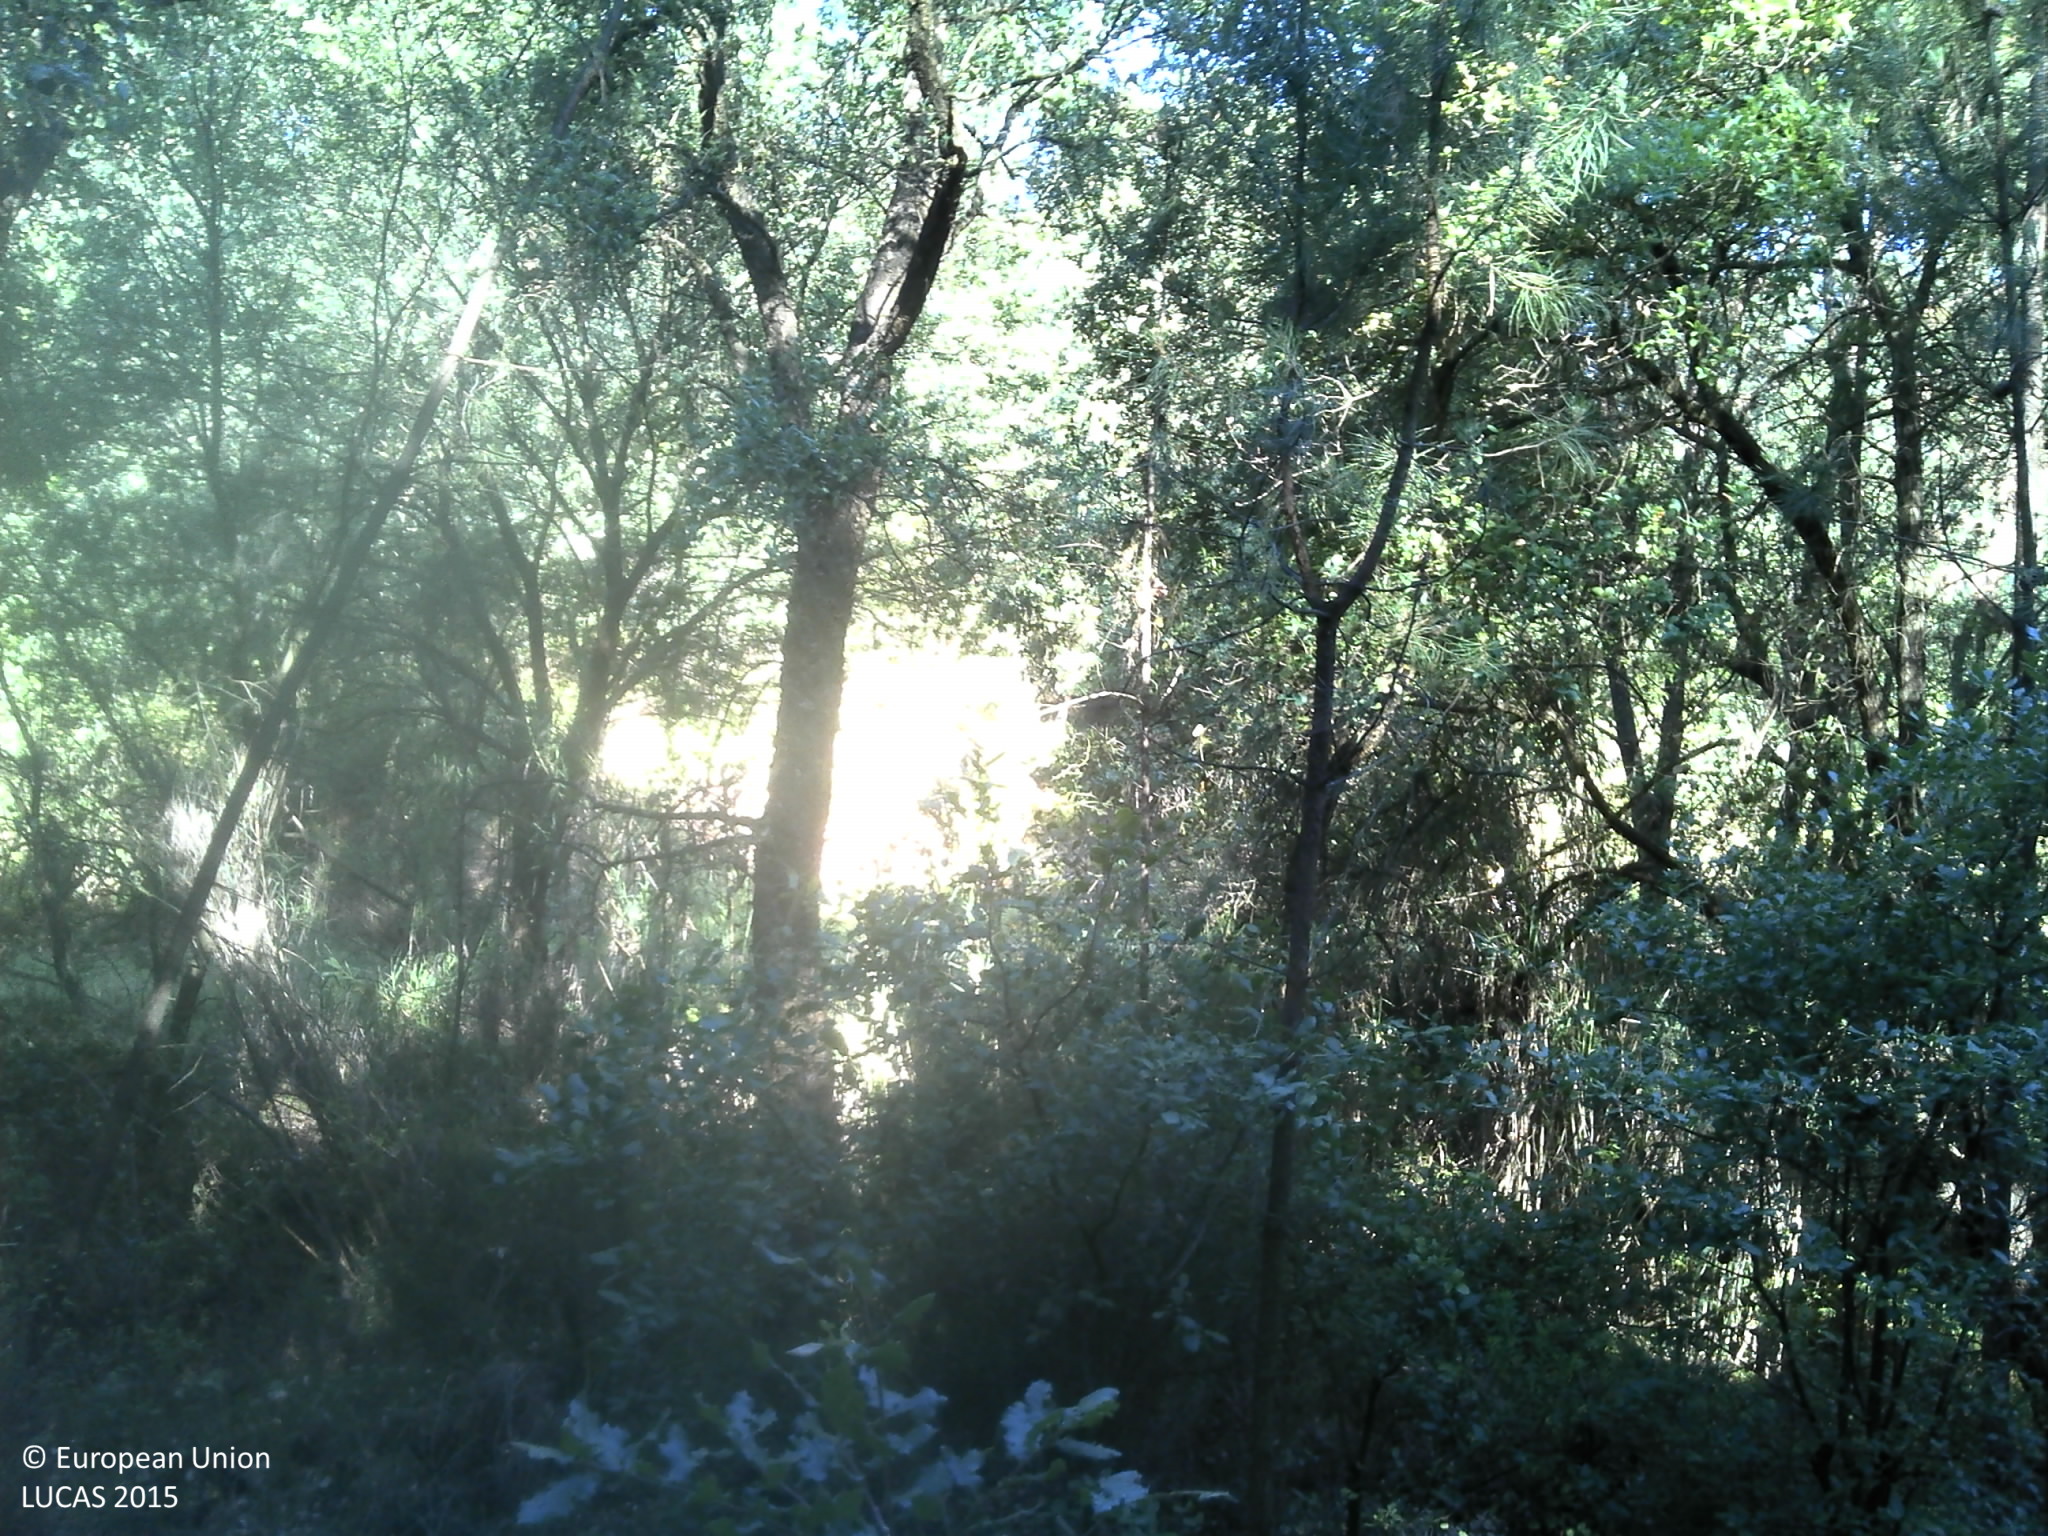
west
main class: Woodland
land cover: Broadleaved woodland
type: mesophytic deciduous forest
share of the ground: 50 - 75 %
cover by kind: broadleaved forest trees 75 %, shrubs 10 %, coniferous forest trees 5 %, herbaceous plants 5 %, unconsolidated bare surface 5 %
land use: Forestry
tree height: > 5 m
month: May
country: PT
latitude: 39.4674
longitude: -8.3278
